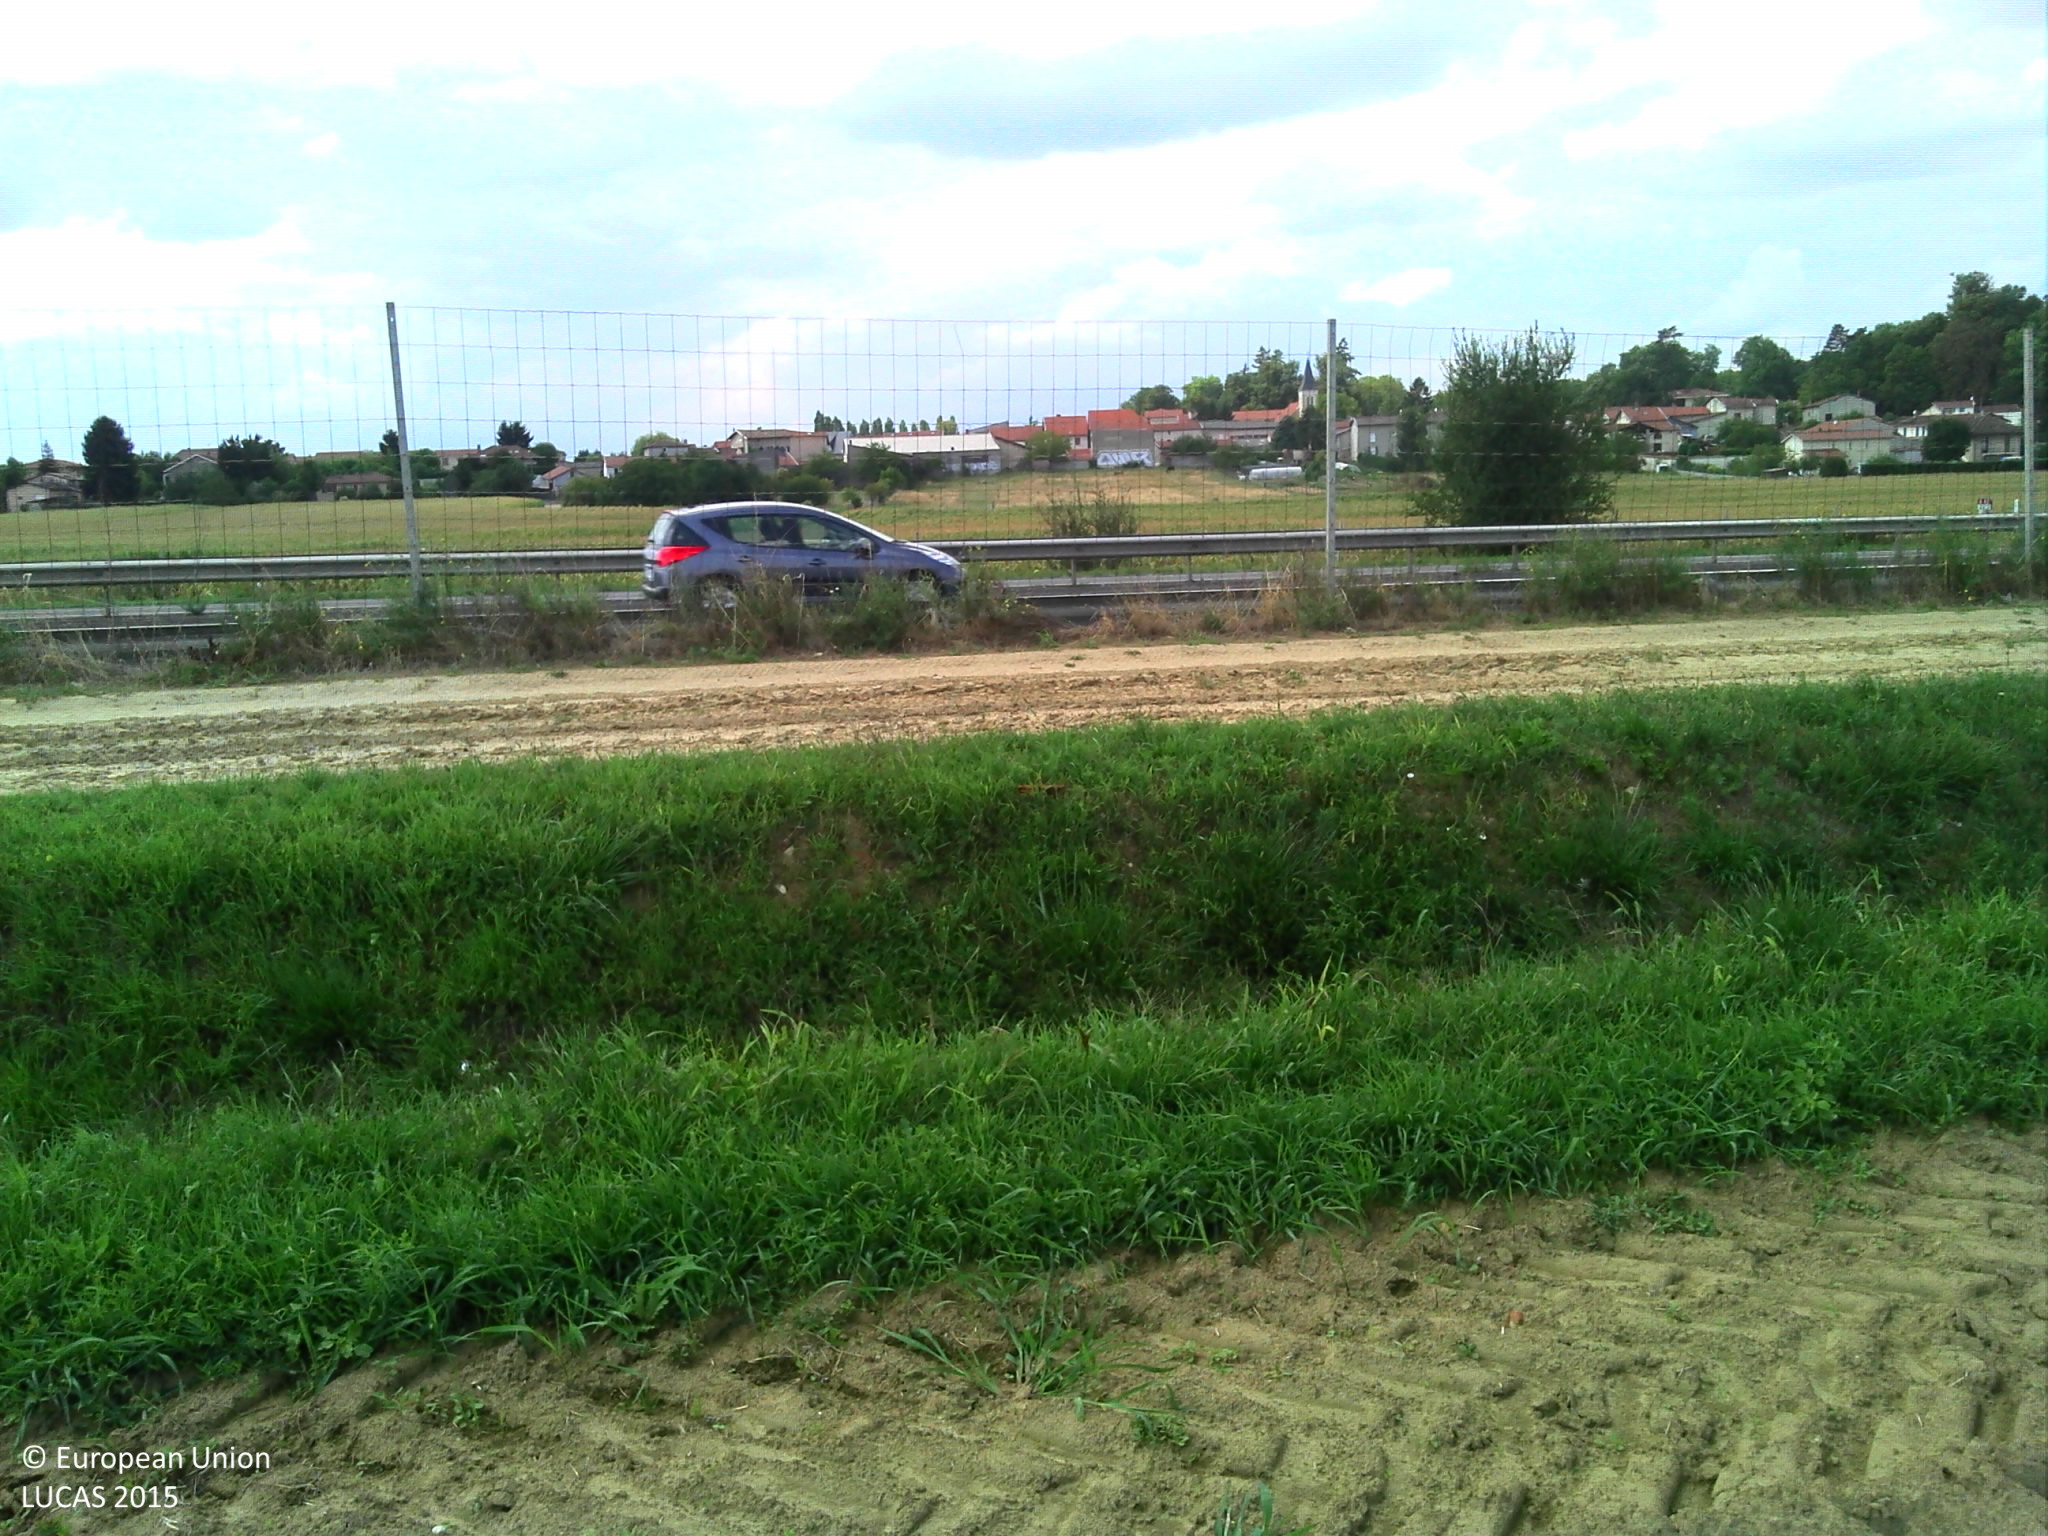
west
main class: Cropland
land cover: Other fresh vegetables
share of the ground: 10 - 25 %
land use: Agriculture (excluding fallow land and kitchen gardens)
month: August
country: FR
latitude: 45.8334
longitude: 4.9183
